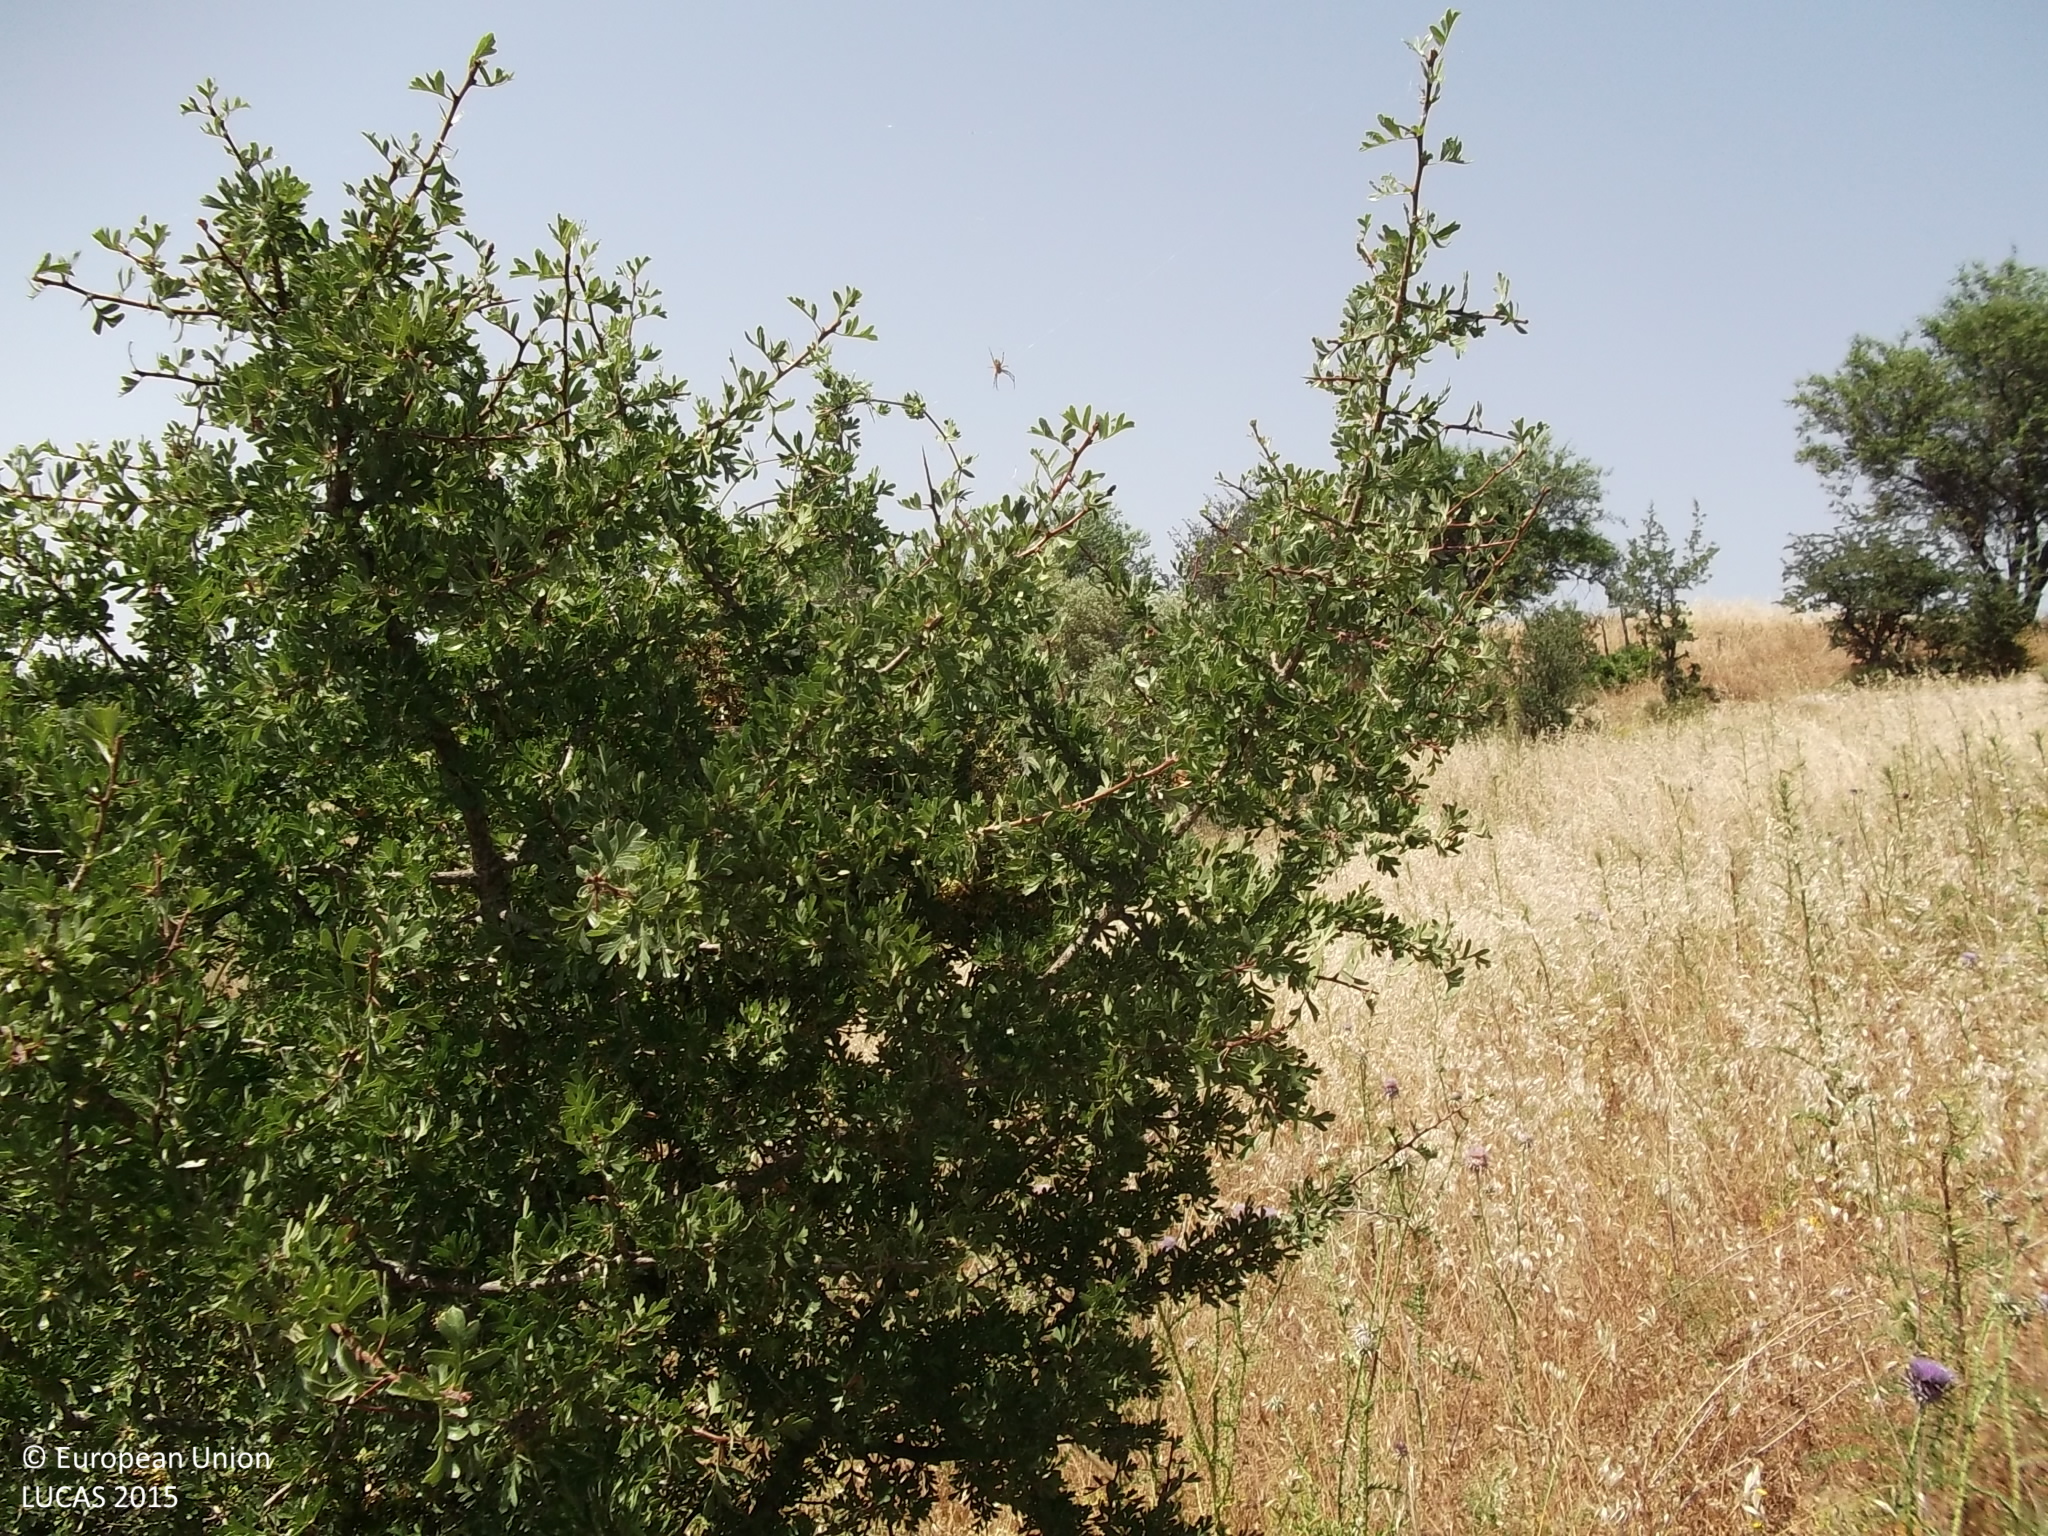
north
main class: Grassland
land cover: Grassland with sparse tree/shrub cover
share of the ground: > 75 %
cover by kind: herbaceous plants 95 %, broadleaved forest trees 5 %
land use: Semi-natural and natural areas not in use
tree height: < 5 m
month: May
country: CY
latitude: 34.8141
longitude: 32.5505
